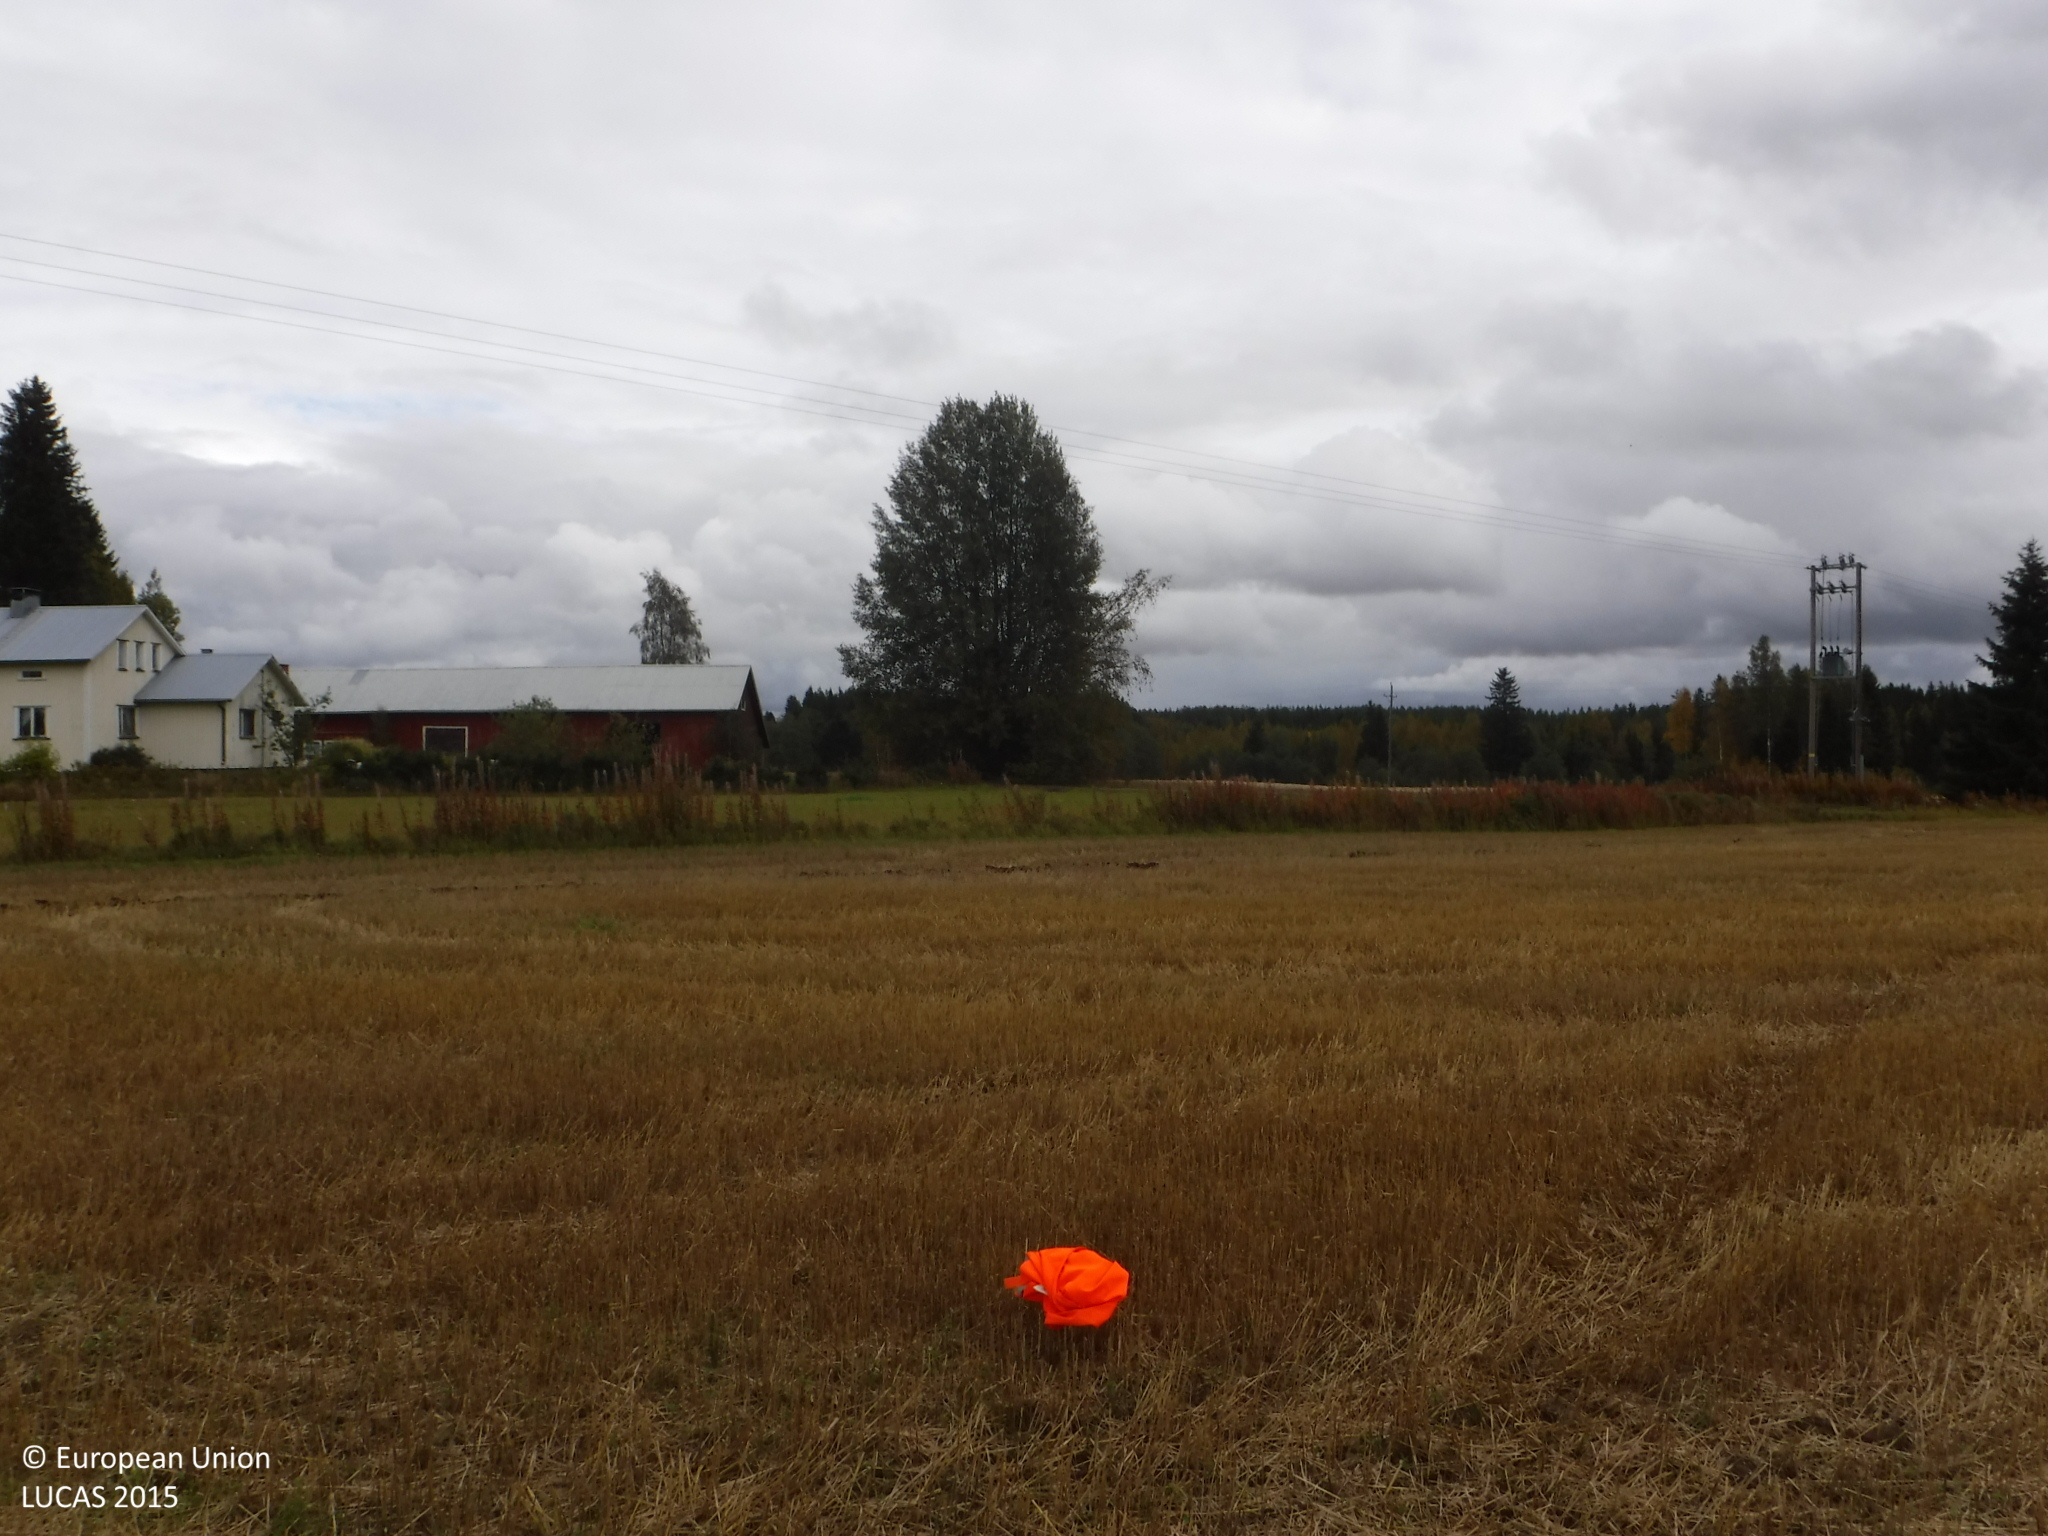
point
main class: Cropland
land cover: Barley
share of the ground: > 75 %
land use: Agriculture (excluding fallow land and kitchen gardens)
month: September
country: FI
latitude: 62.0914
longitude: 22.2549
